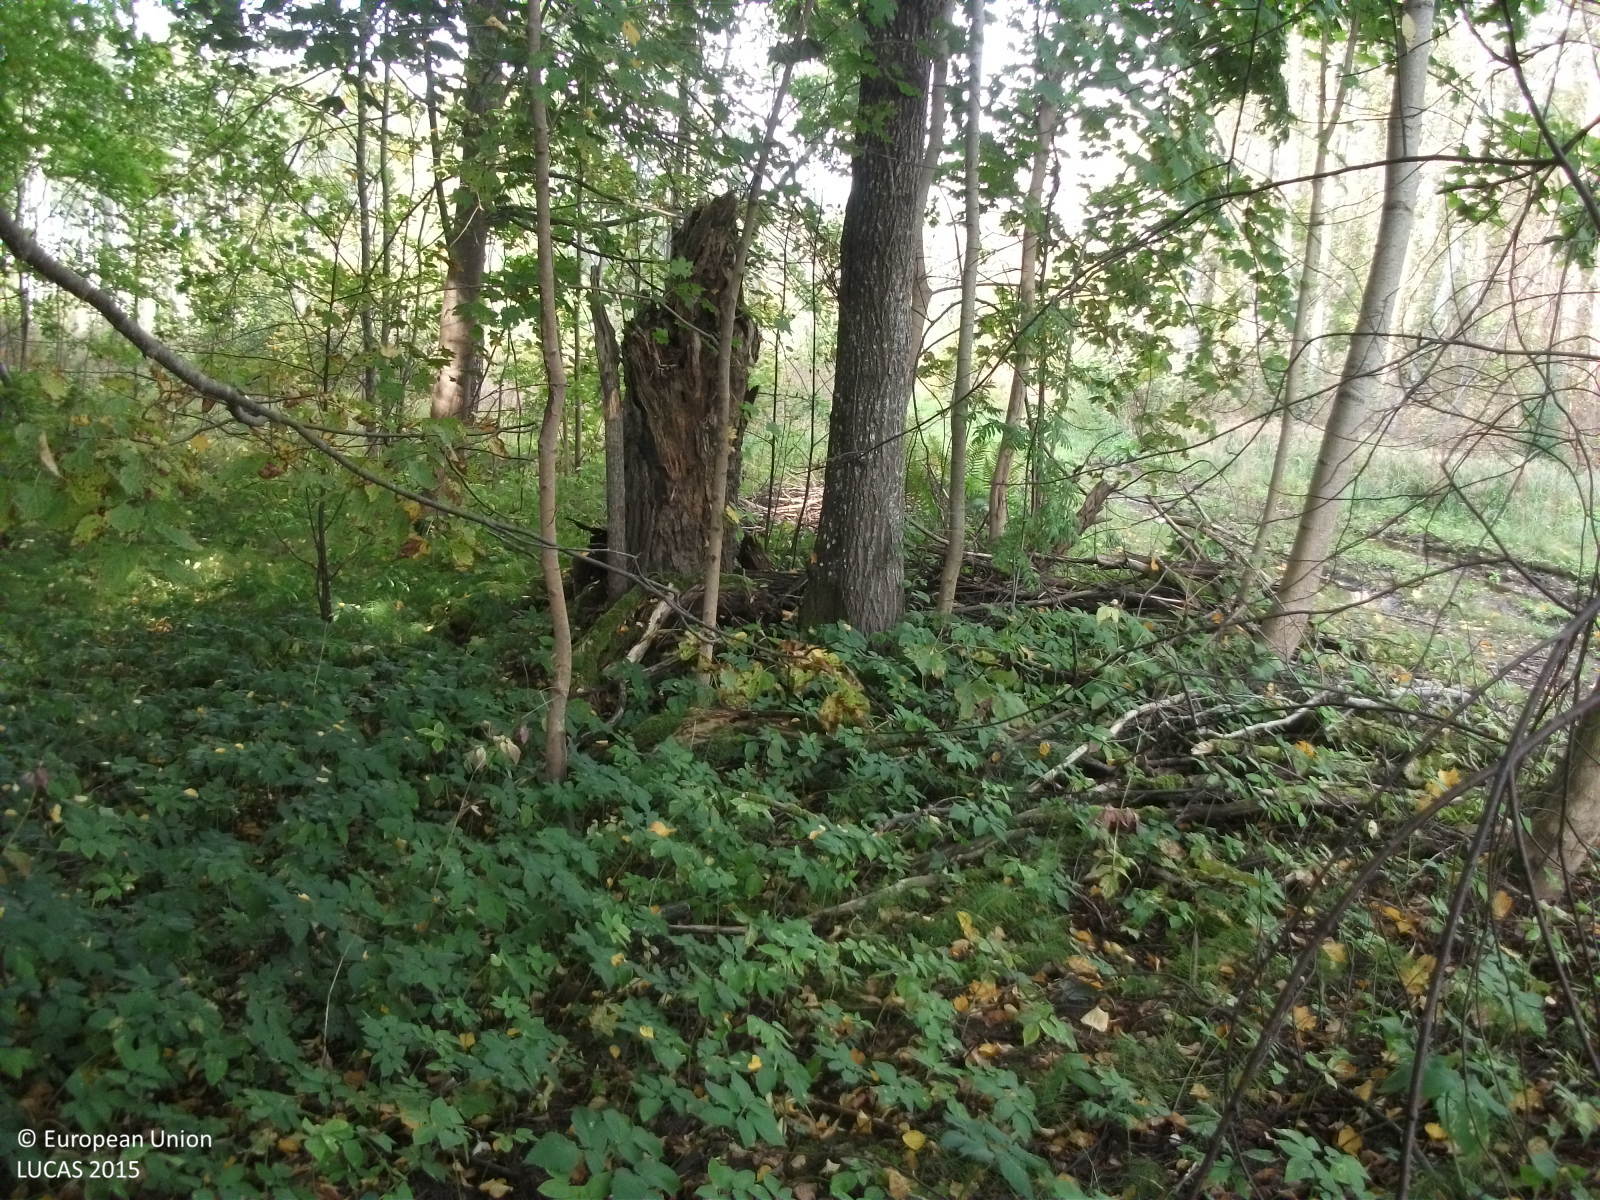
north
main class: Woodland
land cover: Broadleaved woodland
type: non-riverine alder, birch or aspen forest
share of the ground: > 75 %
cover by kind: broadleaved forest trees 85 %, herbaceous plants 10 %, shrubs 5 %
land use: Forestry
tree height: > 5 m
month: September
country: LV
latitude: 57.6204
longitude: 24.5742
